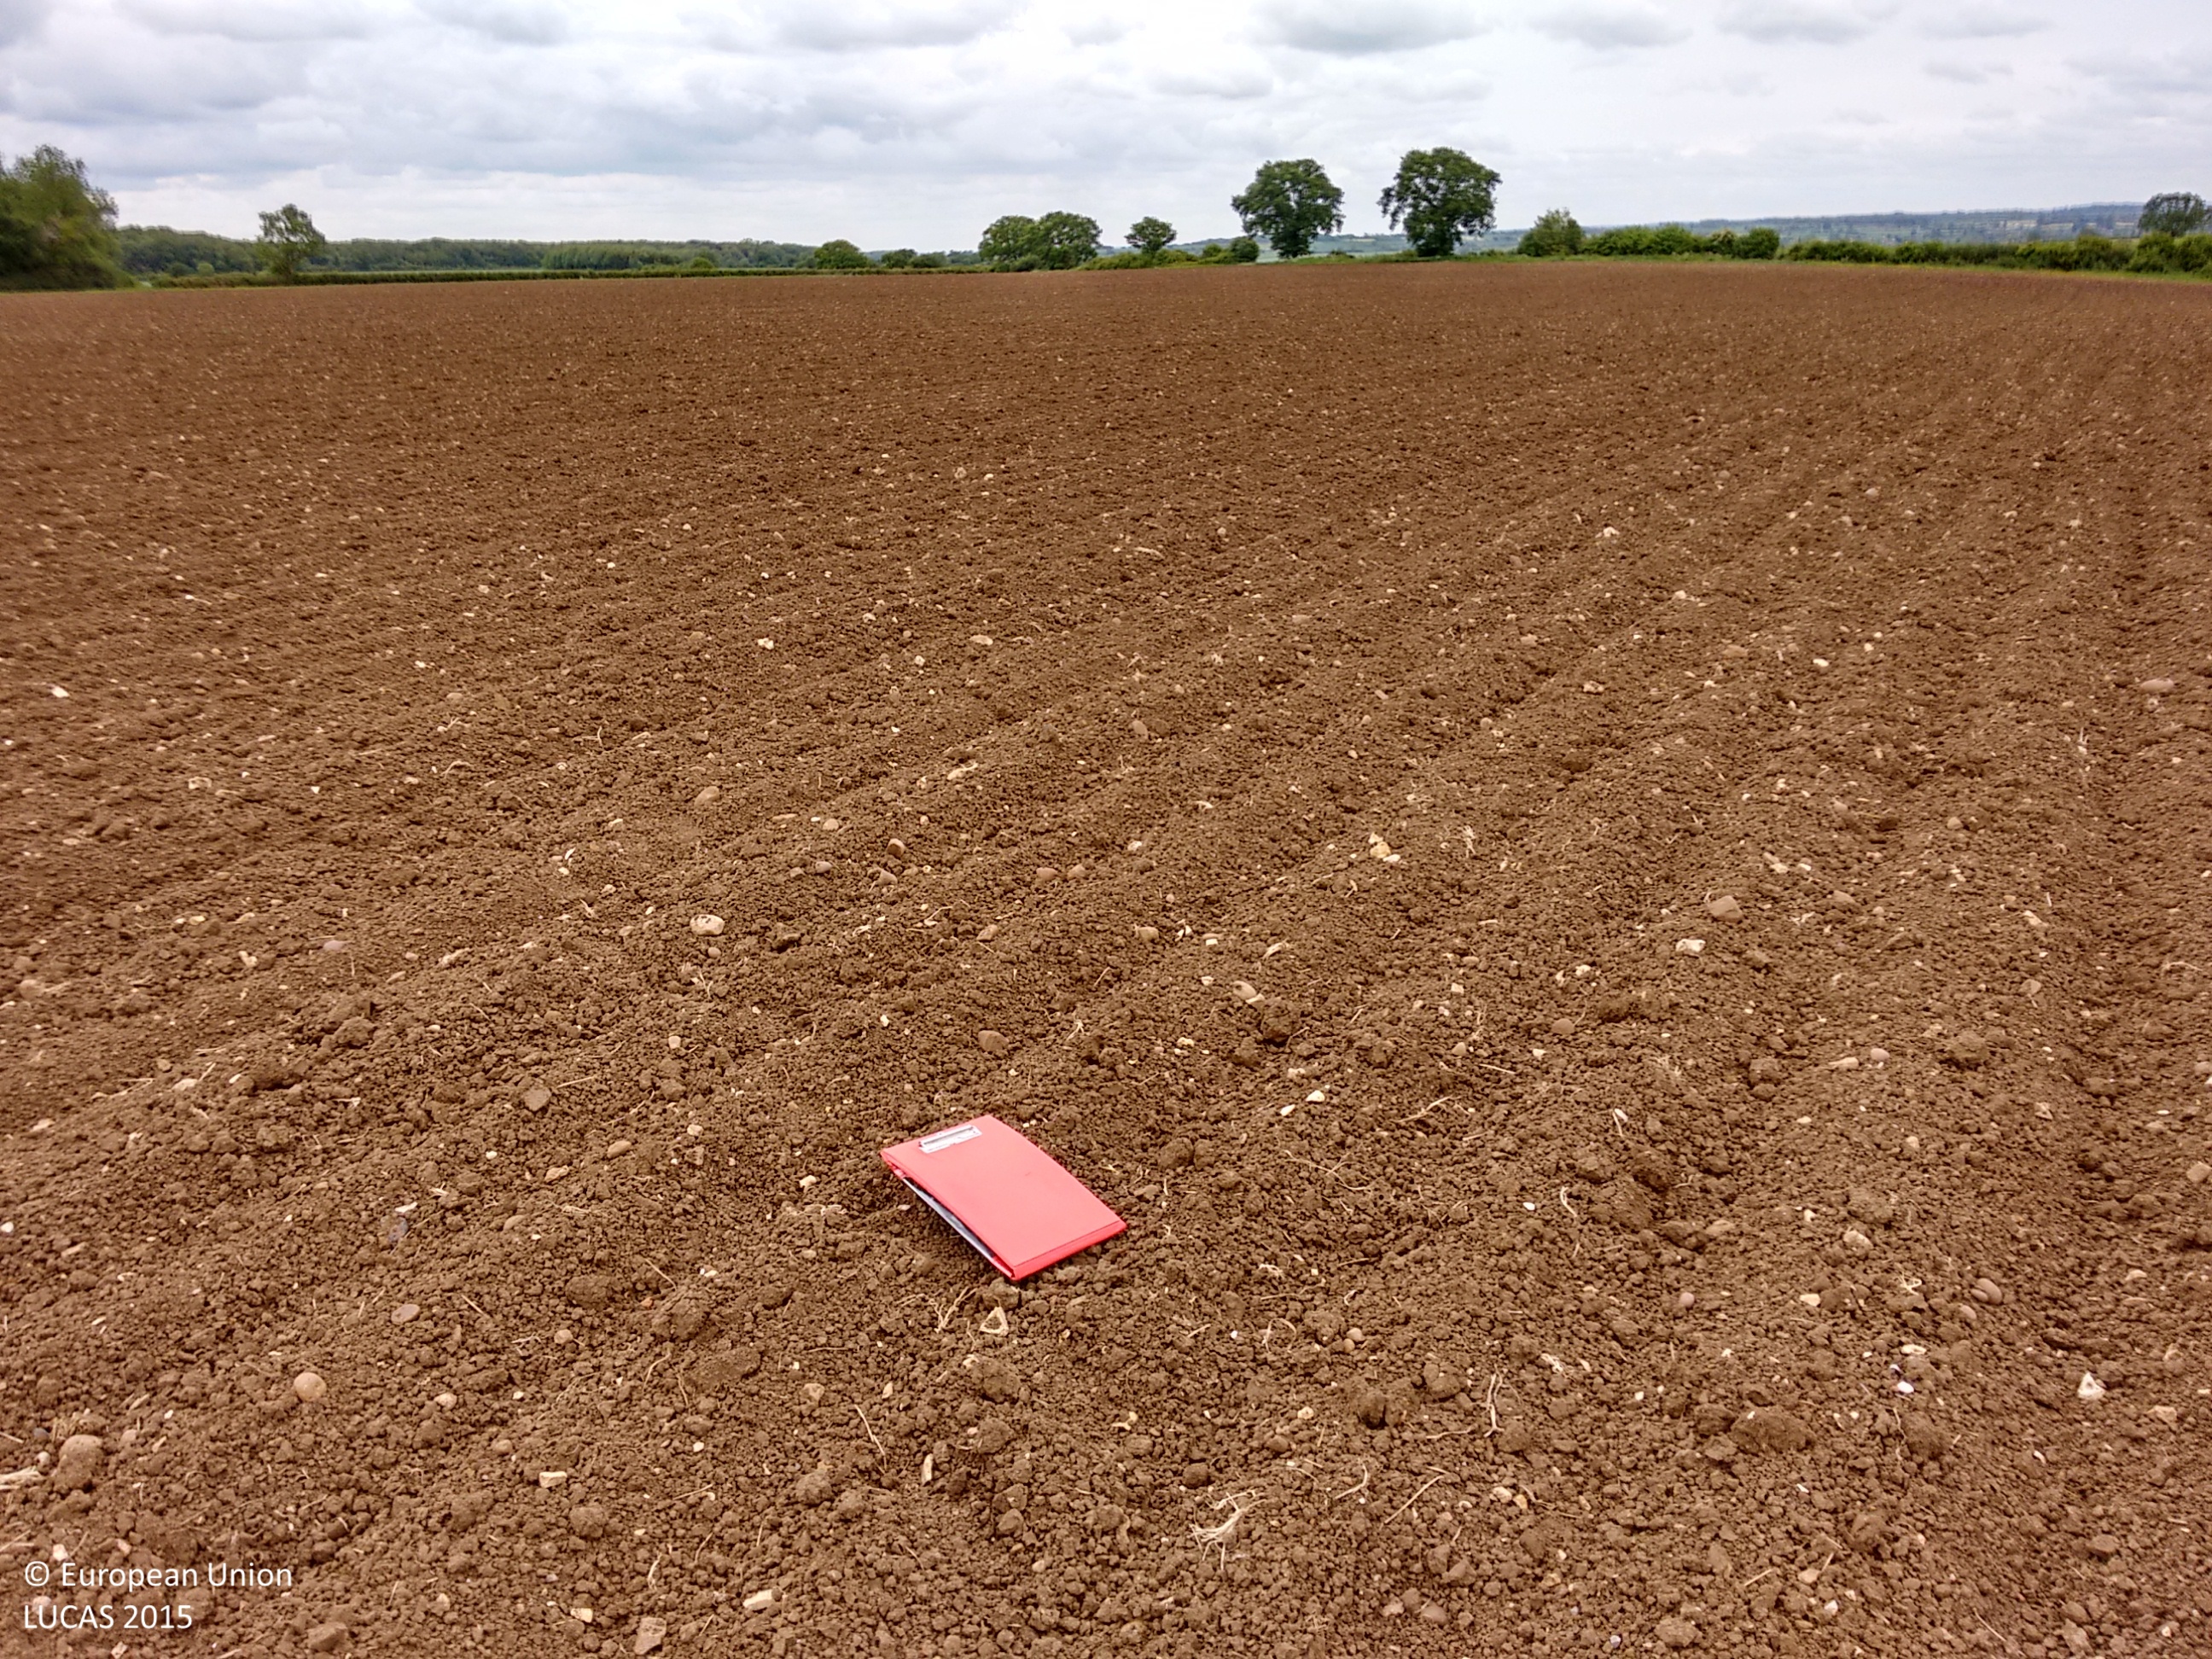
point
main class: Cropland
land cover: Dry pulses
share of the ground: < 10 %
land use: Agriculture (excluding fallow land and kitchen gardens)
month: June
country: GB
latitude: 52.2258
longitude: -0.6242
